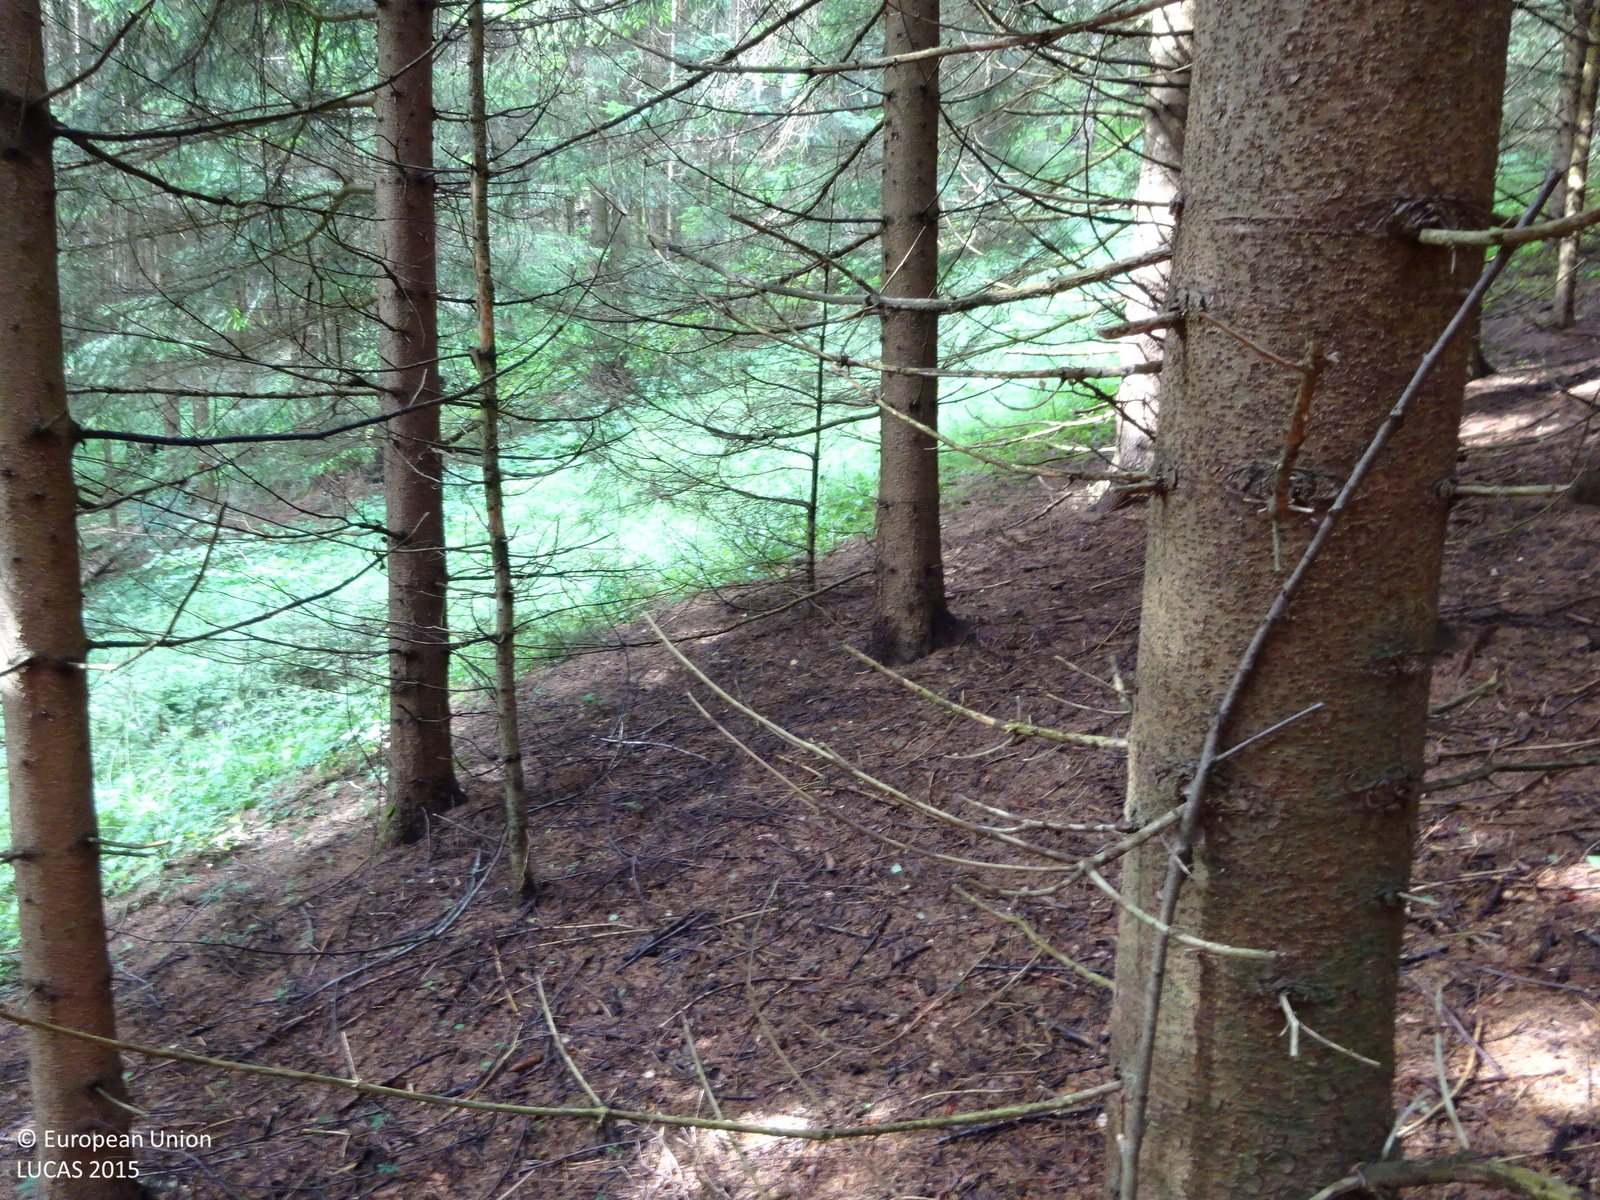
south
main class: Woodland
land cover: Spruce dominated coniferous woodland
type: alpine coniferous forest
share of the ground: > 75 %
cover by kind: coniferous forest trees 75 %, shrubs 20 %, broadleaved forest trees 5 %
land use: Forestry
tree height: > 5 m
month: July
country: AT
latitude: 47.2214
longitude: 15.4806
